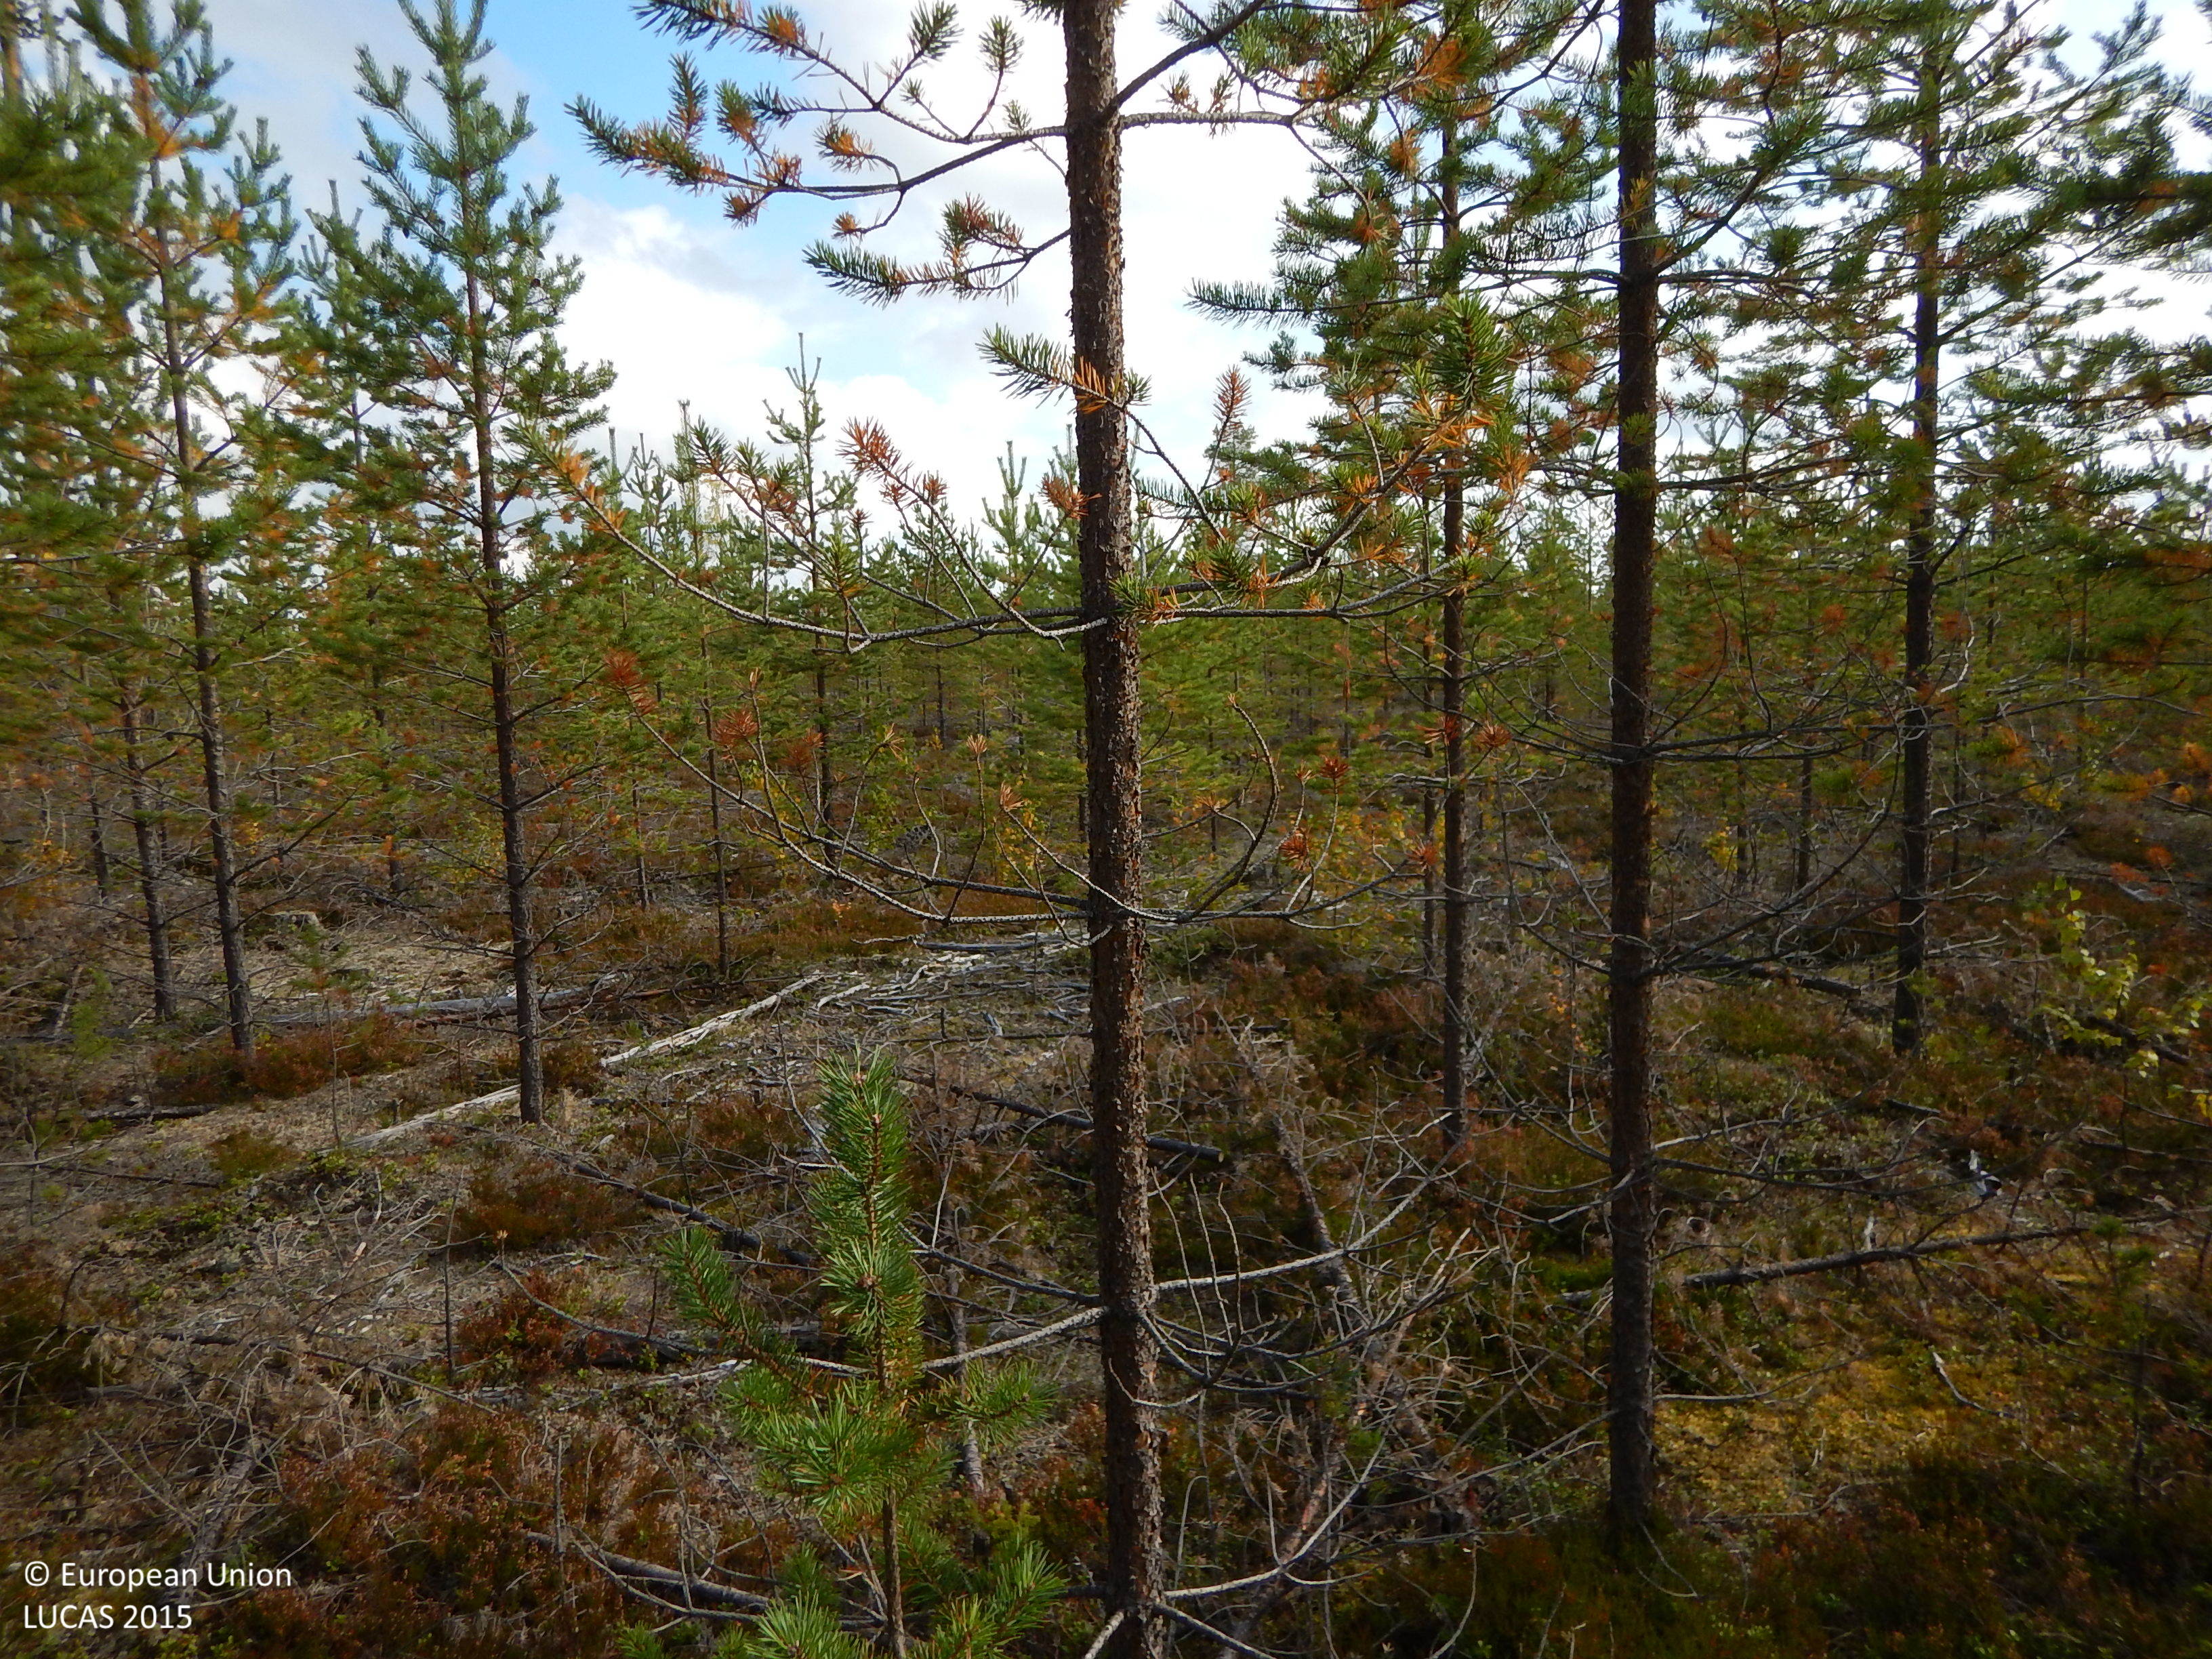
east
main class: Woodland
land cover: Pine dominated coniferous woodland
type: boreal forest
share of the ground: 25 - 50 %
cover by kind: coniferous forest trees 40 %, lichens and mosses 25 %, unconsolidated bare surface 15 %, herbaceous plants 10 %, broadleaved forest trees 5 %, shrubs 5 %
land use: Forestry
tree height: < 5 m
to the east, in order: Pine dominated coniferous woodland; Ditches and canals; Grass margins; Paved roads, cycling and walking lanes; Grass margins; Ditches and canals; Pine dominated coniferous woodland; Paved roads, cycling and walking lanes; Pine dominated coniferous woodland
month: September
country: SE
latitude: 64.8150
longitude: 20.2292
